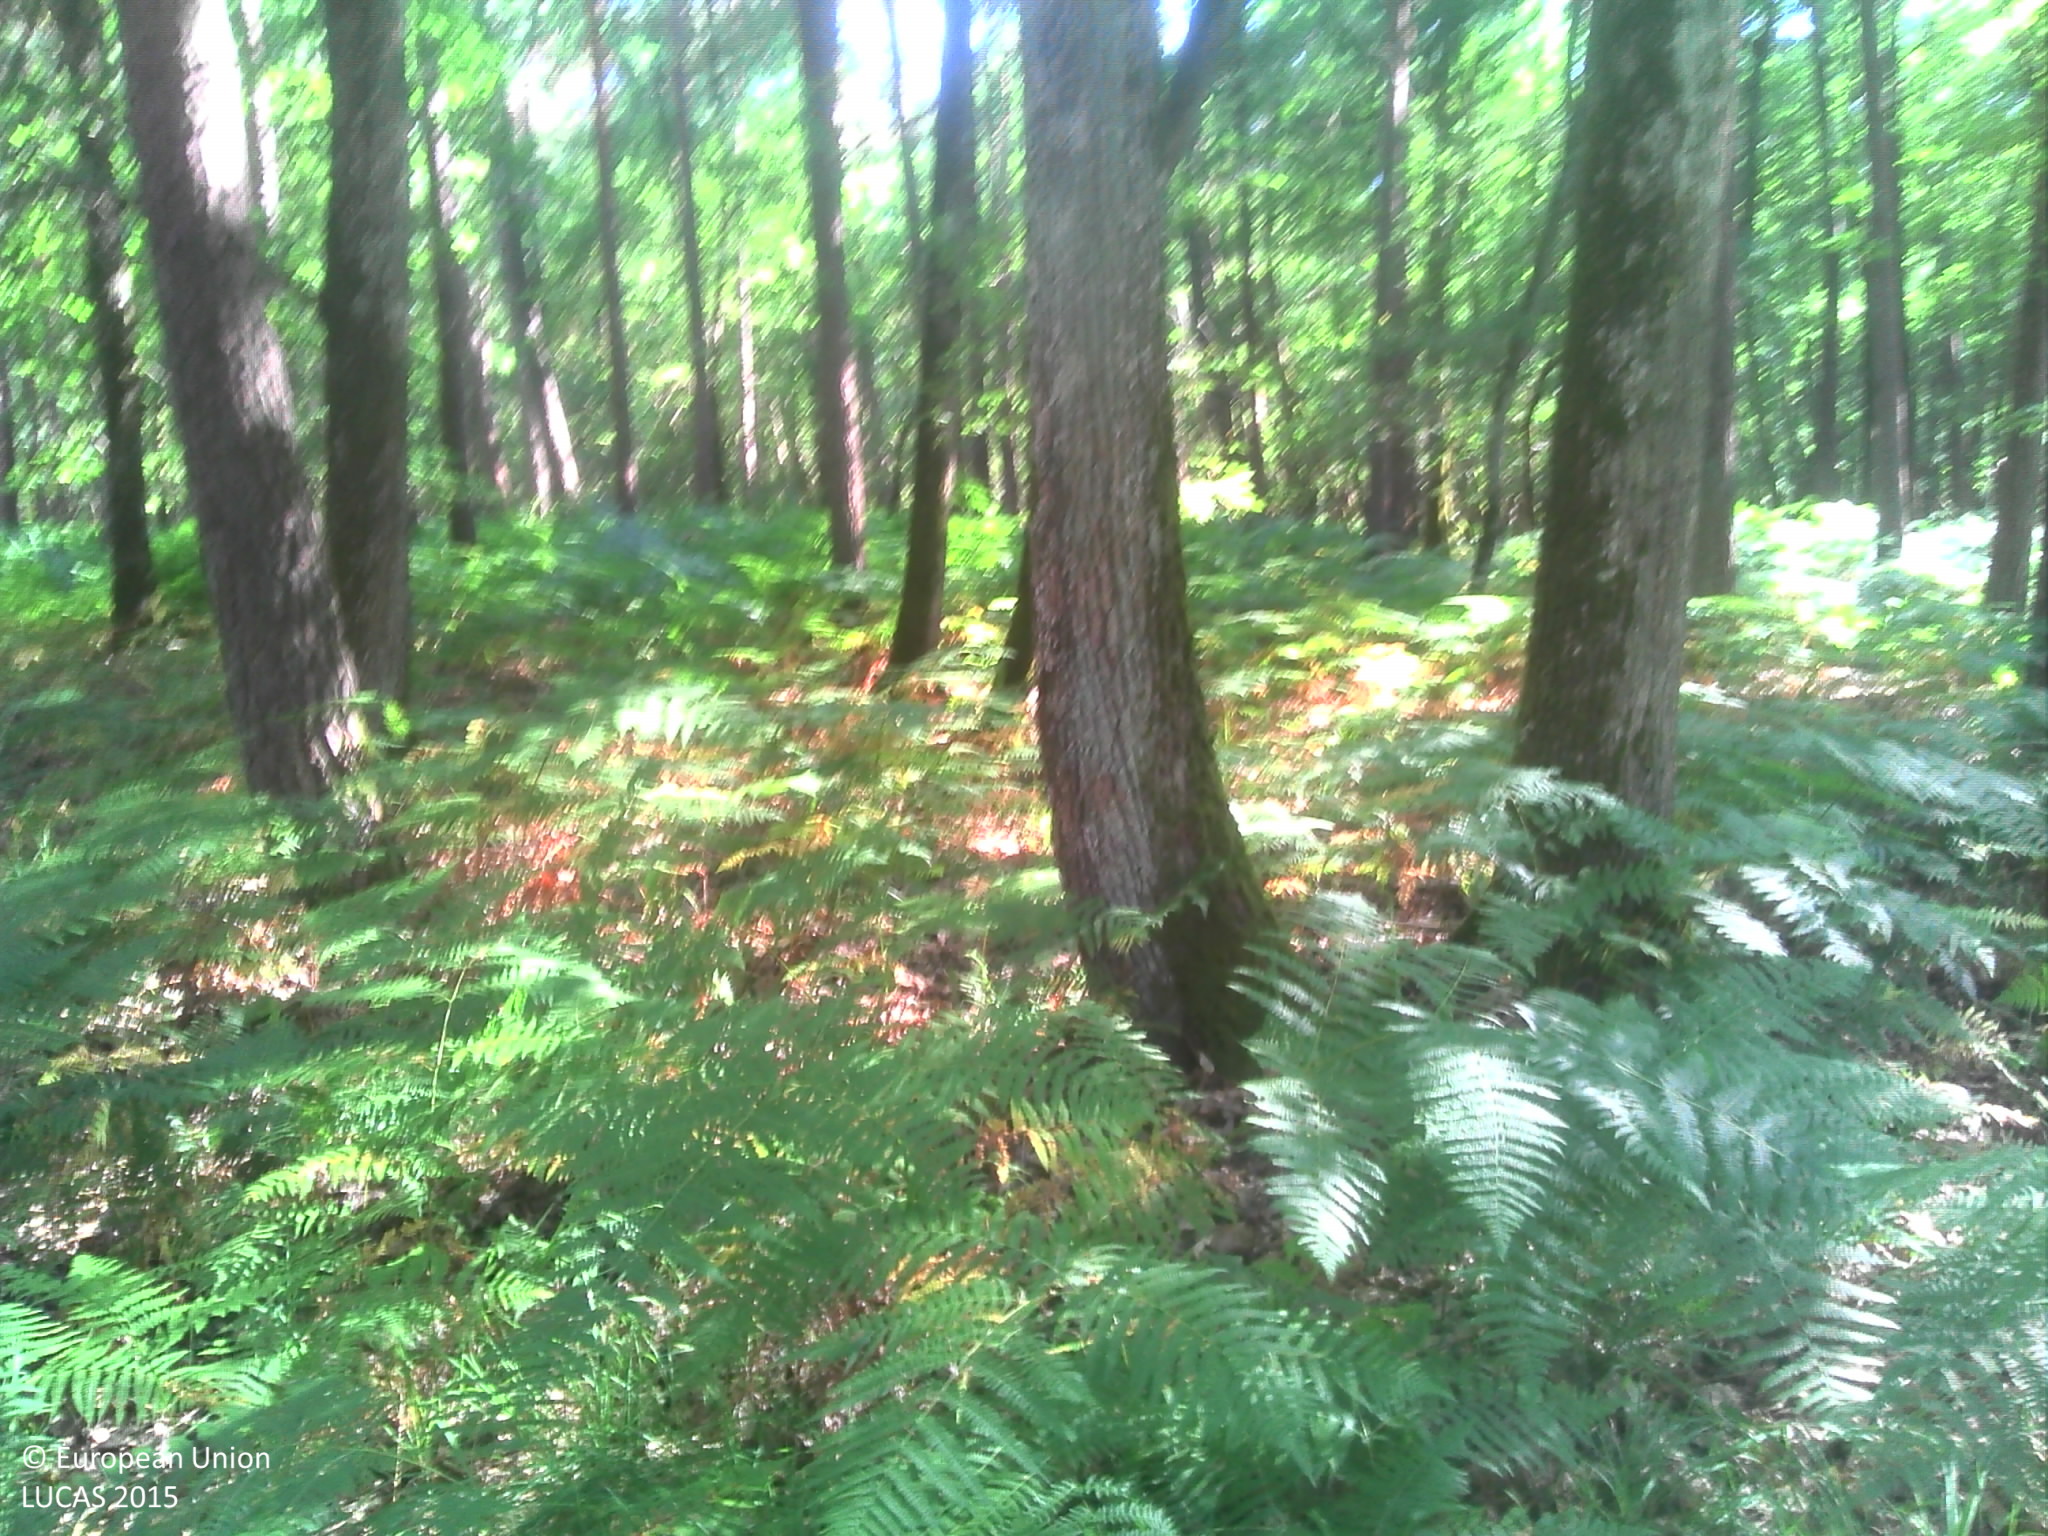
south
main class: Woodland
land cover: Pine dominated mixed woodland
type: thermophilous deciduous forest
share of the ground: > 75 %
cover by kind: herbaceous plants 40 %, unconsolidated bare surface 35 %, coniferous forest trees 15 %, broadleaved forest trees 10 %
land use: Forestry
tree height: > 5 m
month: June
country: FR
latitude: 47.3101
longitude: 1.4280
